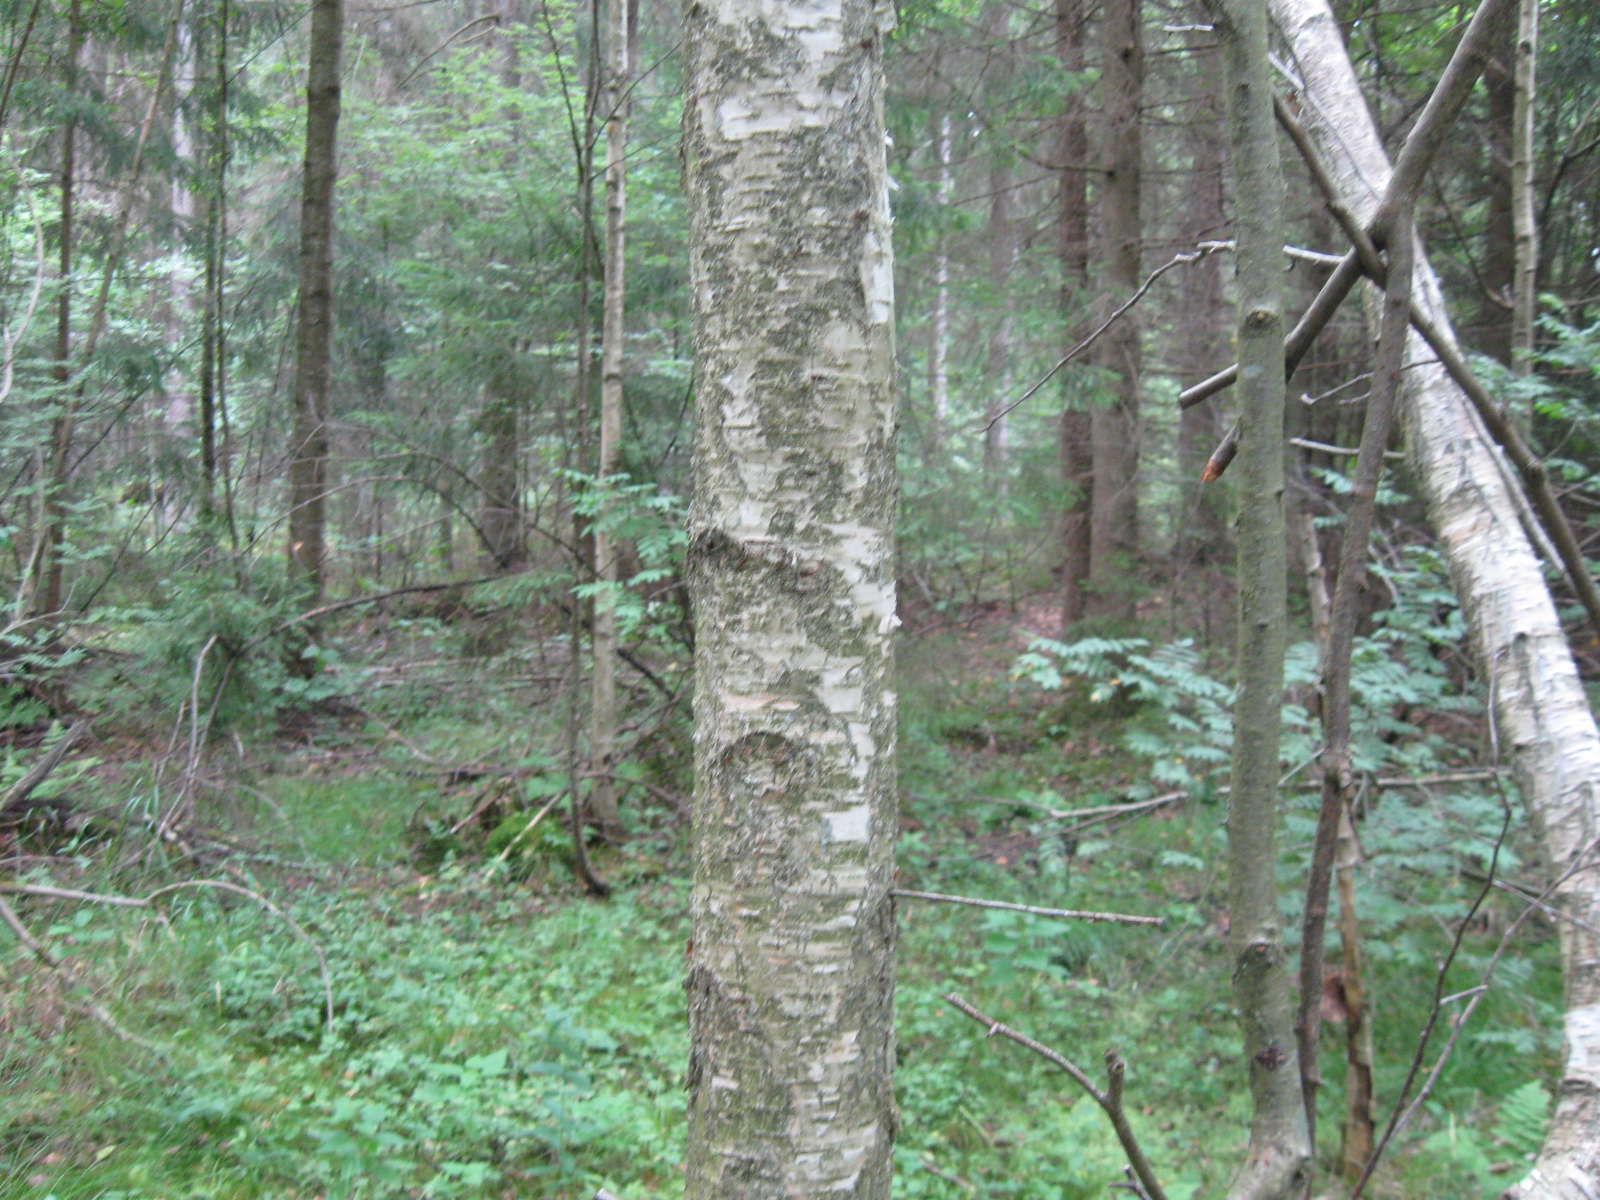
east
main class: Woodland
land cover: Broadleaved woodland
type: non-riverine alder, birch or aspen forest
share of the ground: > 75 %
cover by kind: broadleaved forest trees 75 %, herbaceous plants 10 %, coniferous forest trees 5 %, shrubs 5 %, lichens and mosses 5 %
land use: Forestry
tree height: > 5 m
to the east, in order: Broadleaved woodland; Spruce dominated coniferous woodland; Pine dominated coniferous woodland; Tracks; Pine dominated coniferous woodland; Other structural elements; Other coniferous woodland
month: July
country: LT
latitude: 54.7698
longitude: 23.5591
